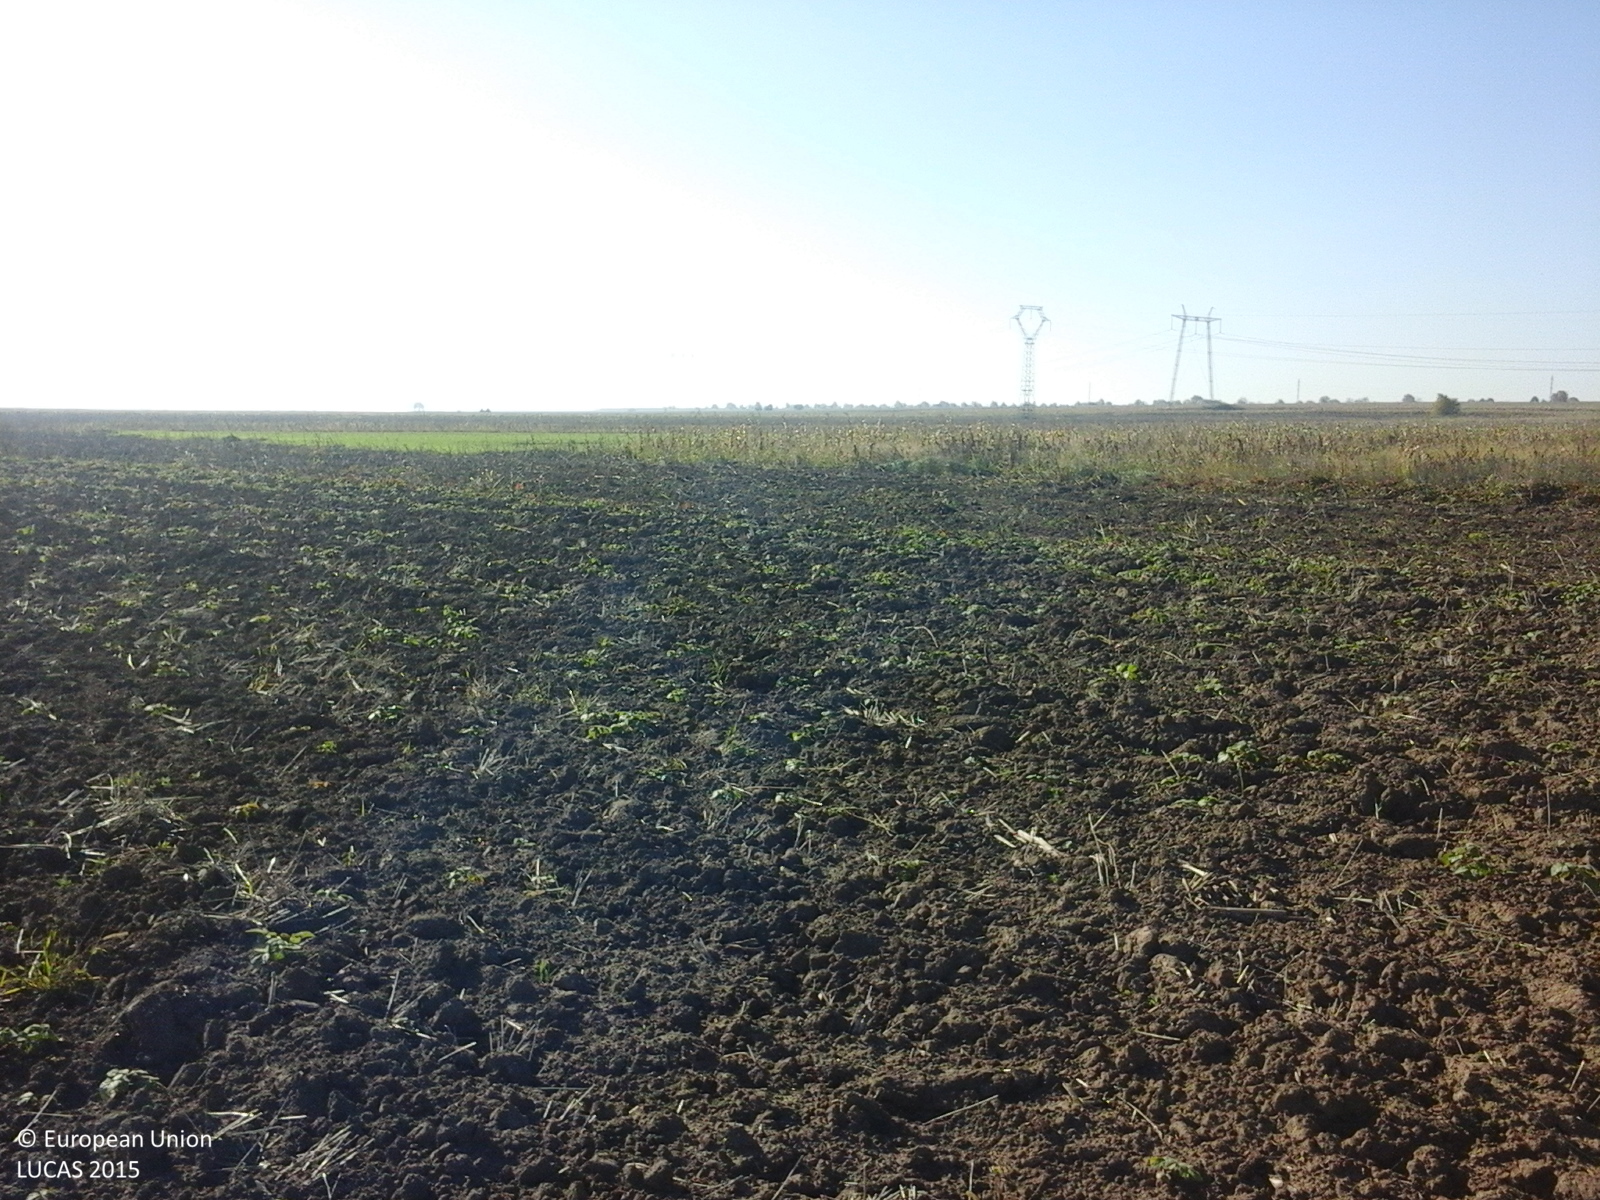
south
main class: Cropland
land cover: Common wheat
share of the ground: < 10 %
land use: Agriculture (excluding fallow land and kitchen gardens)
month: October
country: RO
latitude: 45.9442
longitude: 27.1622
